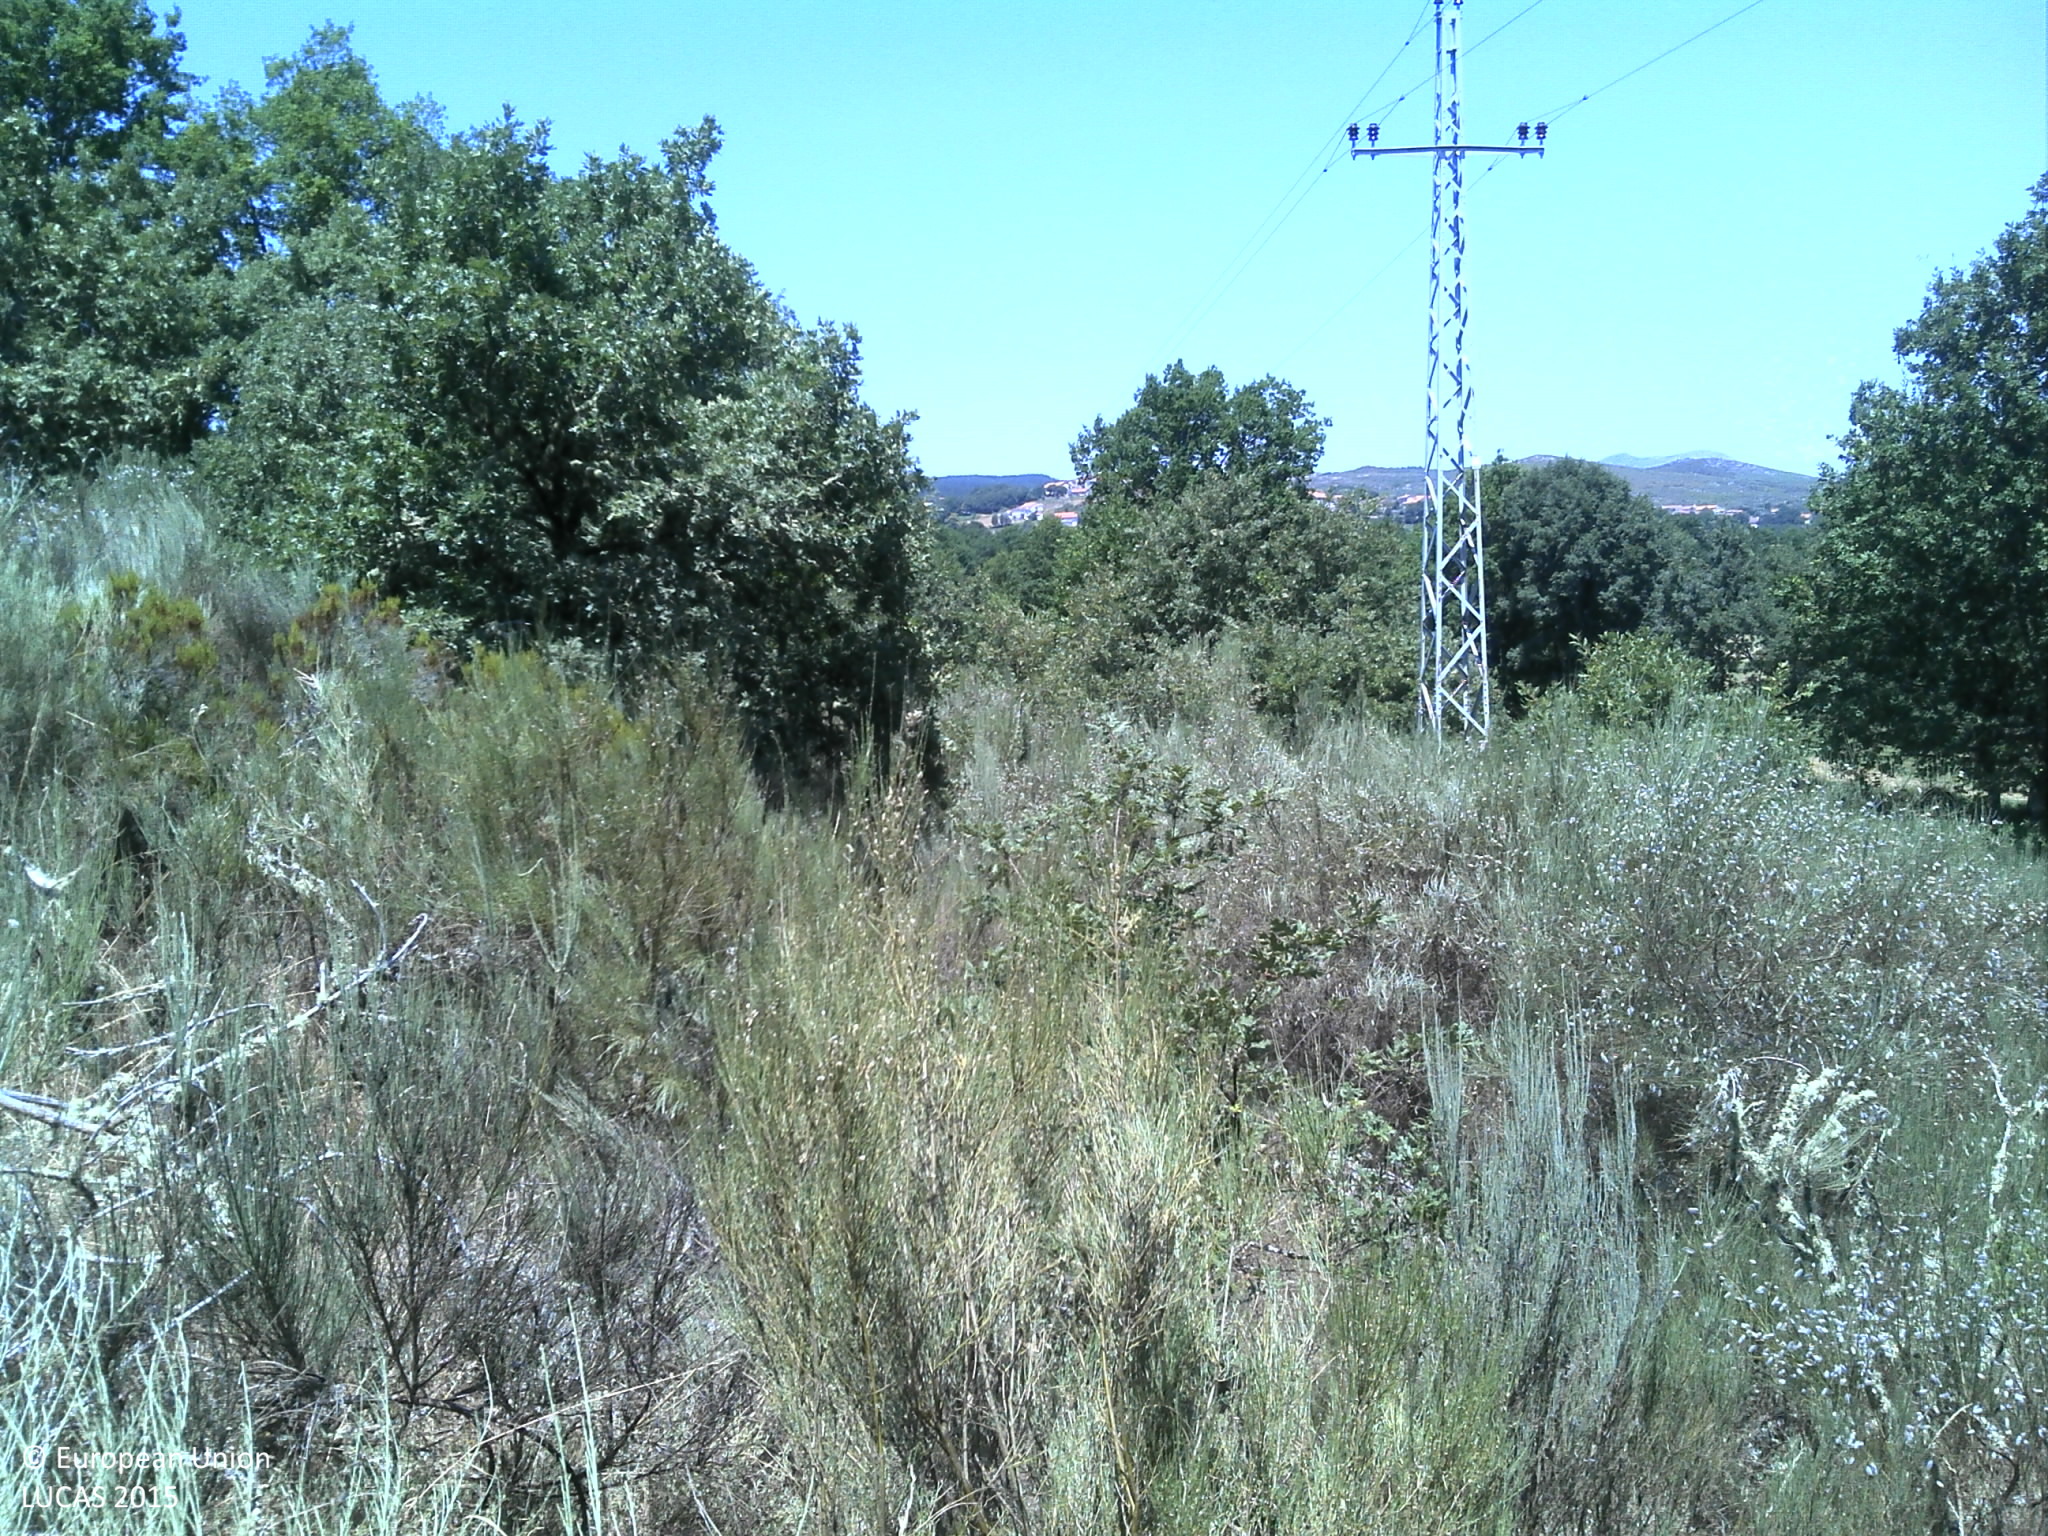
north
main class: Shrubland
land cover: Shrubland without tree cover
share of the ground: > 75 %
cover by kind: shrubs 90 %, herbaceous plants 5 %, unconsolidated bare surface 5 %
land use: Semi-natural and natural areas not in use
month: July
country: PT
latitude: 41.7835
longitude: -7.7905
